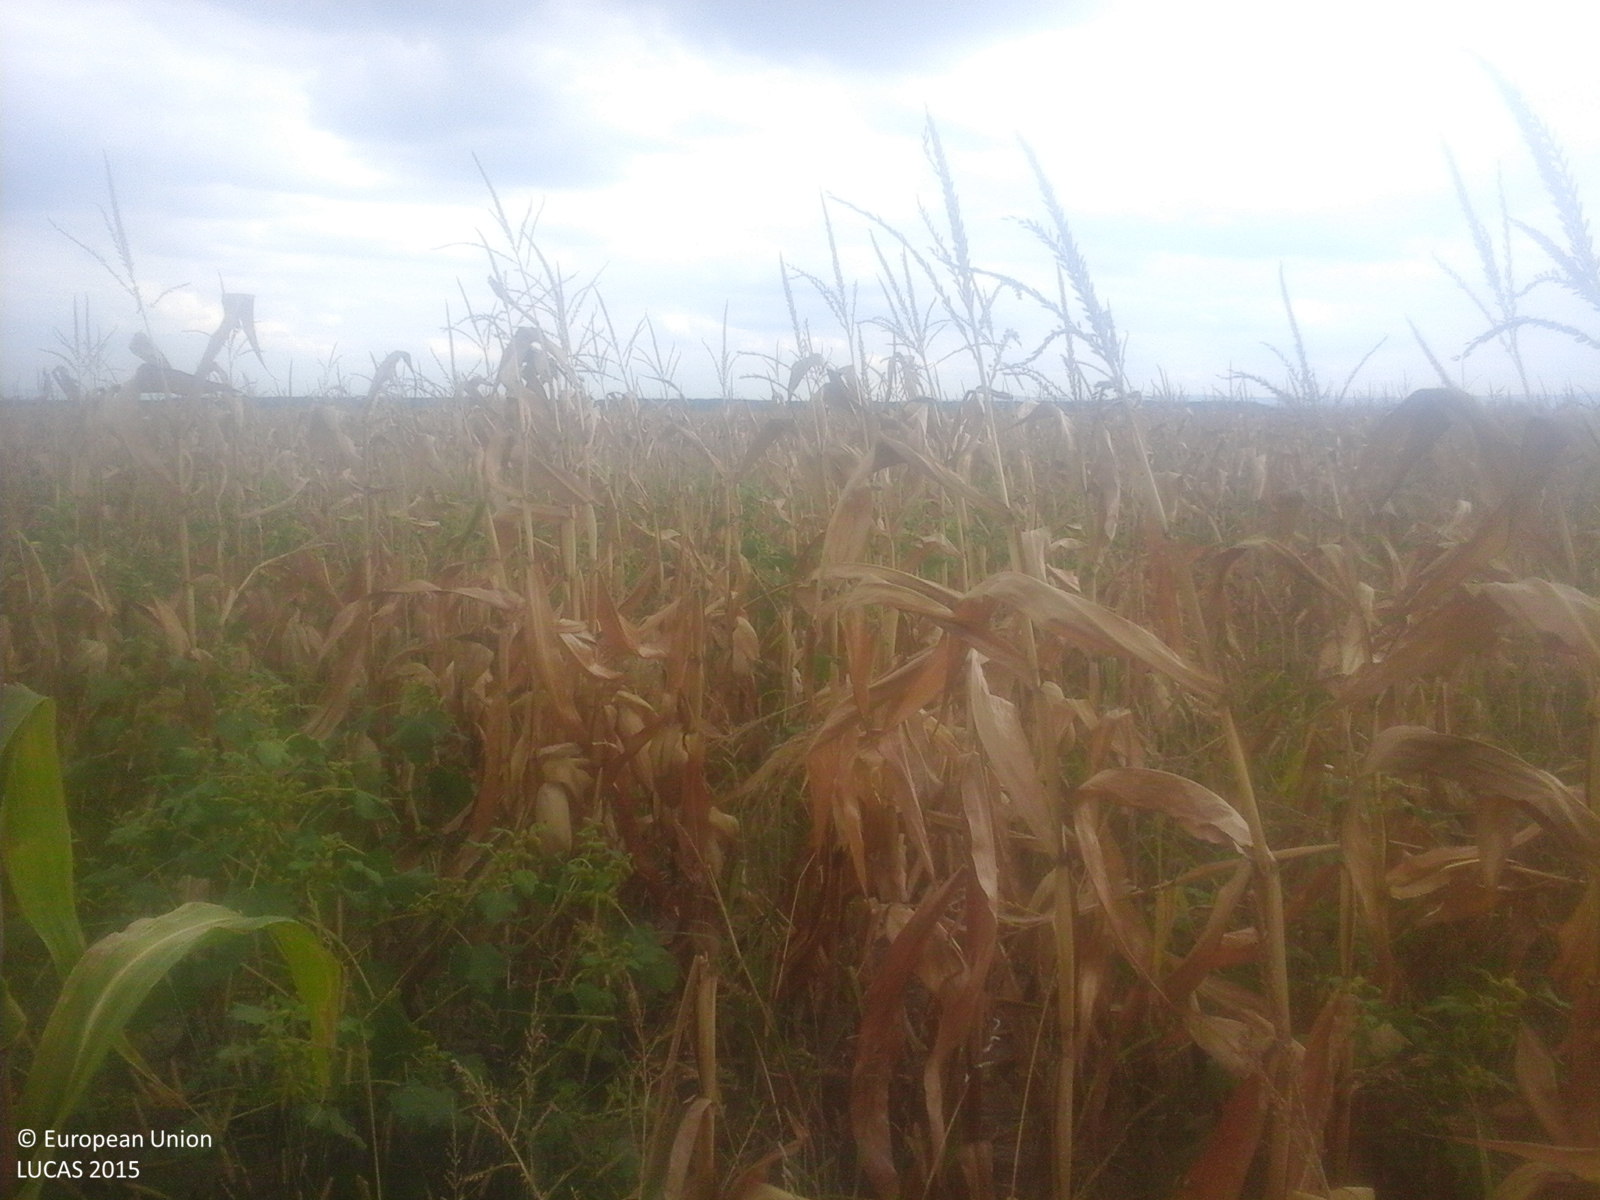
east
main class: Cropland
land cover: Maize
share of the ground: > 75 %
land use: Agriculture (excluding fallow land and kitchen gardens)
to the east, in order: Maize; Shruby margins; Ditches and canals; Shruby margins; Tracks; Shruby margins; Maize
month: September
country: RO
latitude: 47.7115
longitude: 22.7916
